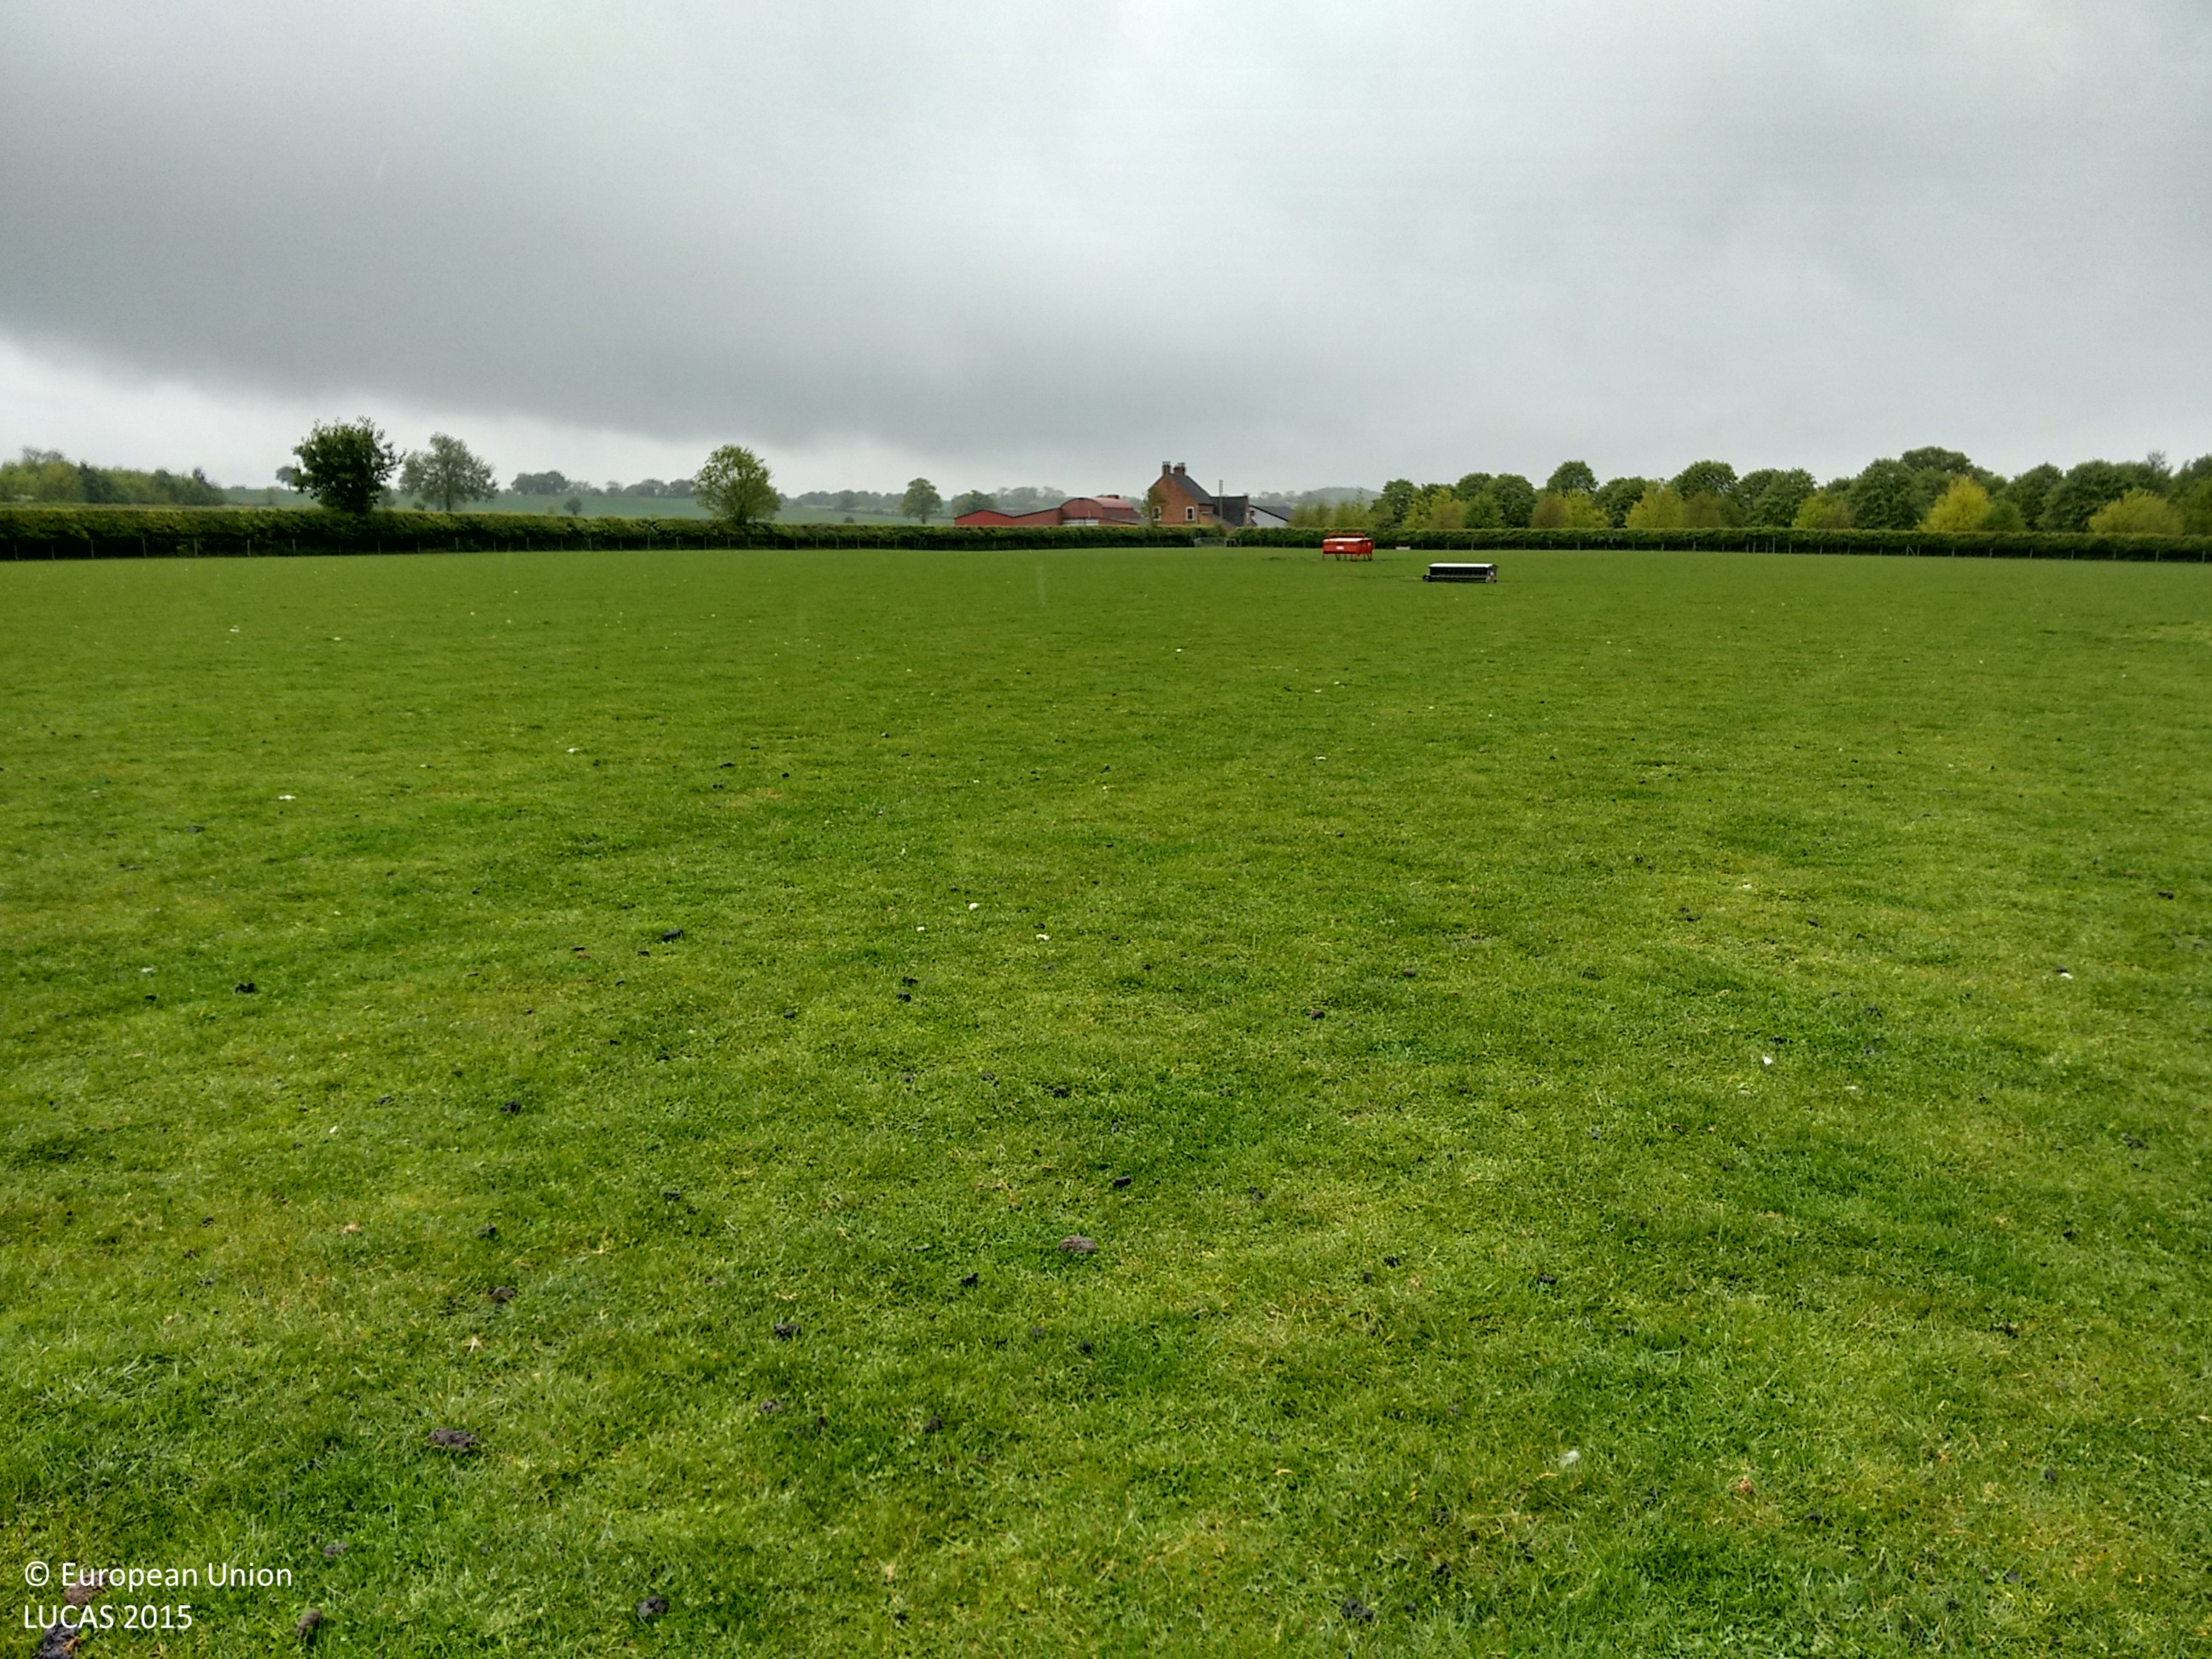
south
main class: Grassland
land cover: Grassland without tree/shrub cover
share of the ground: > 75 %
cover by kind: herbaceous plants 100 %
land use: Agriculture (excluding fallow land and kitchen gardens)
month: May
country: GB
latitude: 52.3708
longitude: -1.4032
